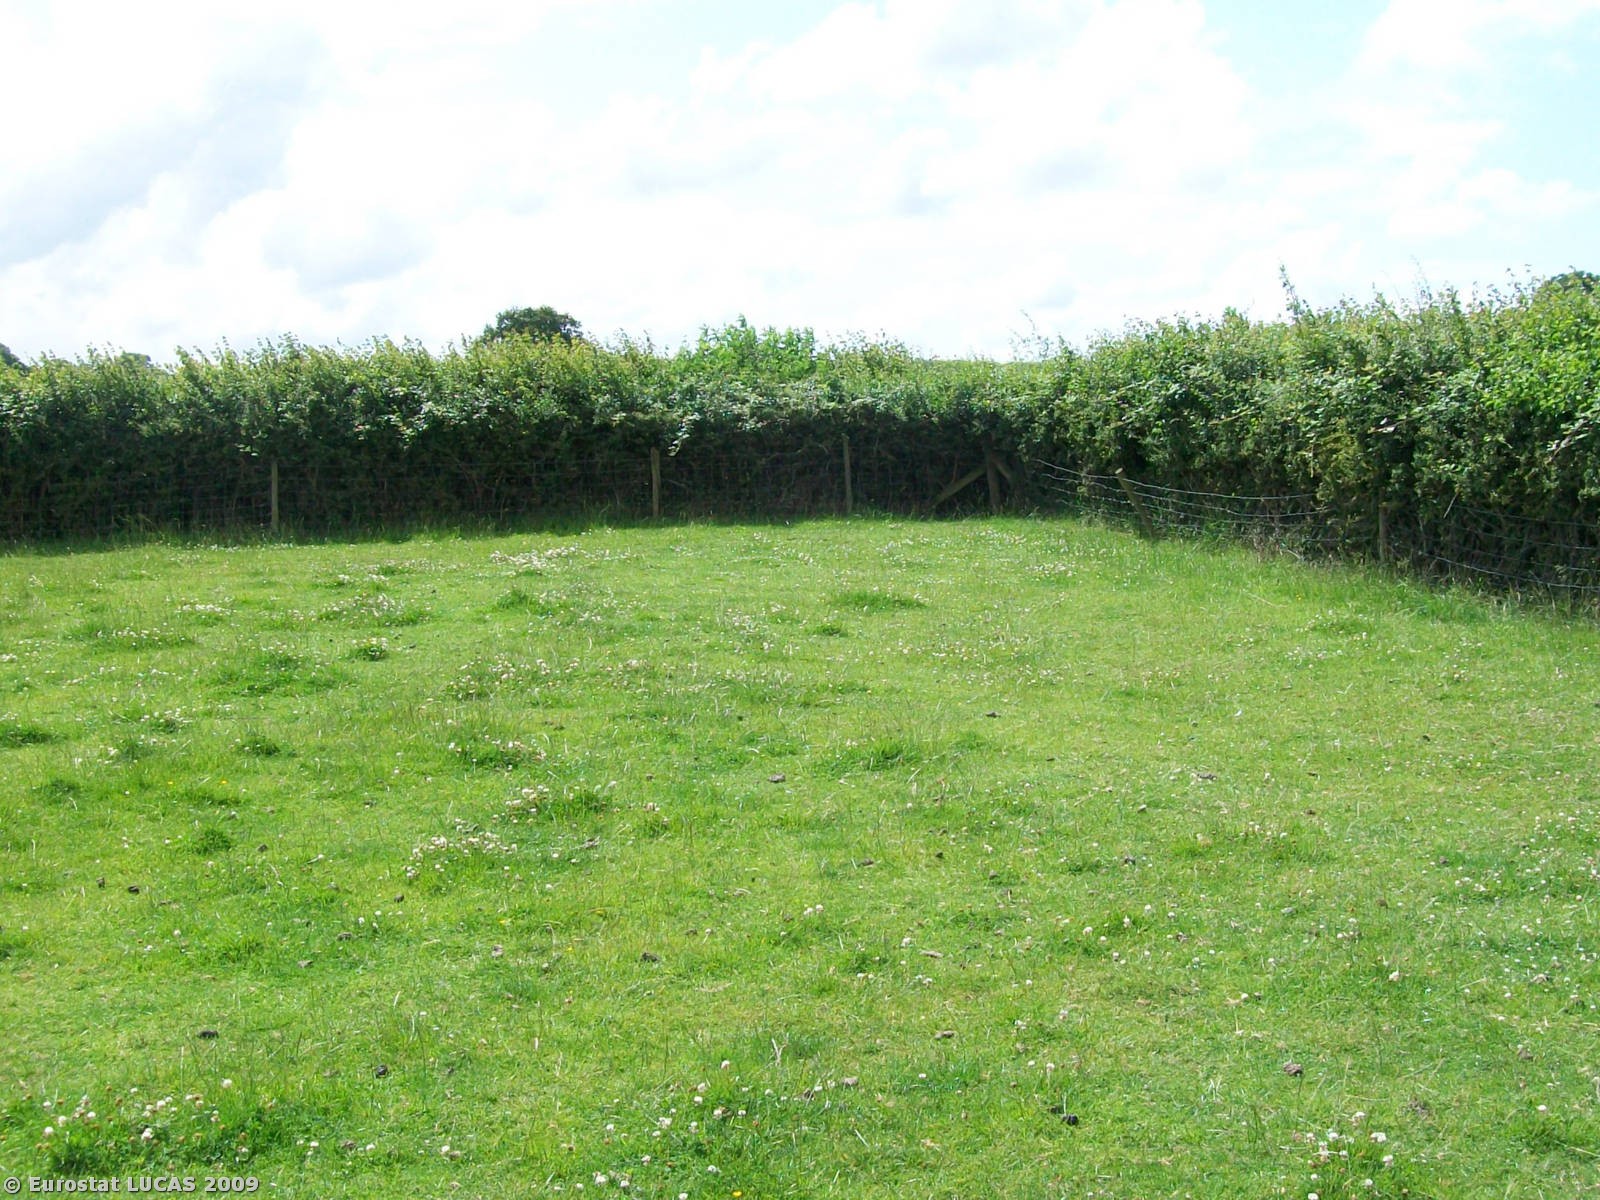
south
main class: Grassland
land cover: Grassland without tree/shrub cover
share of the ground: > 75 %
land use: Agriculture (excluding fallow land and kitchen gardens)
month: July
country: GB
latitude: 51.1195
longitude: -2.7717
